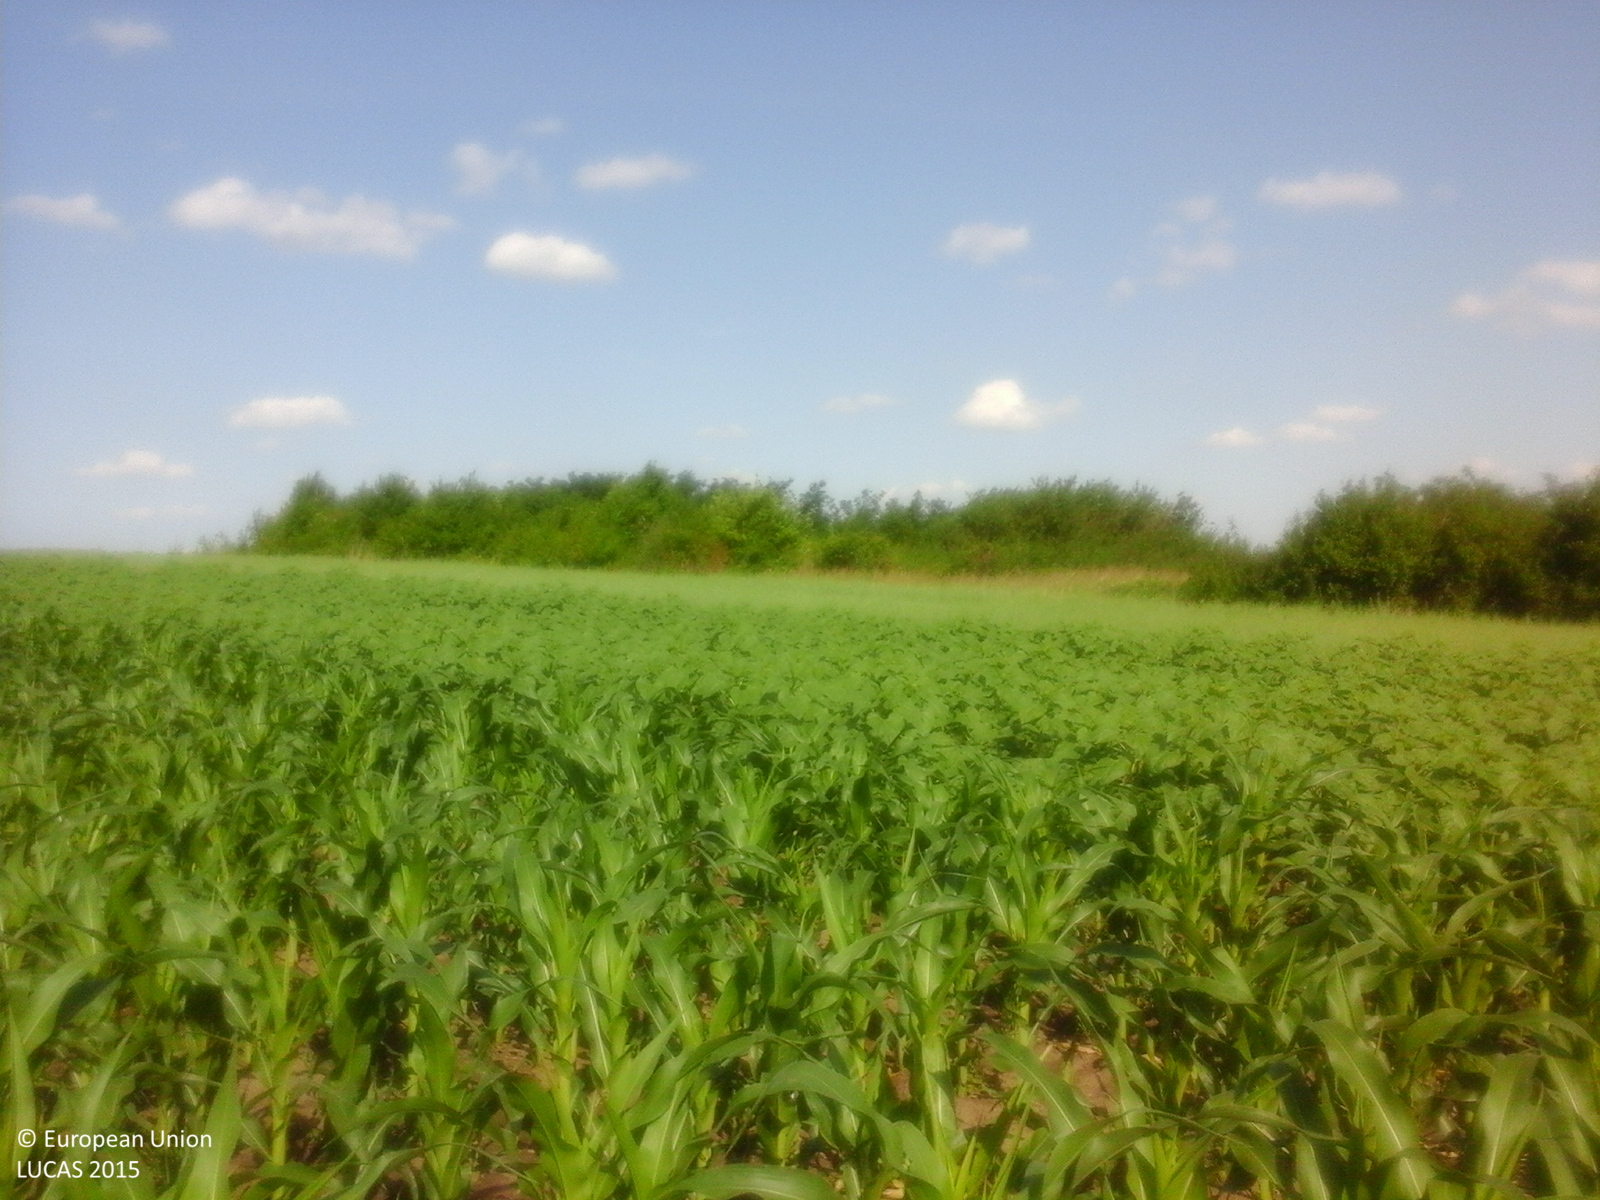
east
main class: Cropland
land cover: Maize
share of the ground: > 75 %
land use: Agriculture (excluding fallow land and kitchen gardens)
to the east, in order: Maize; Sunflower; Oats; Abandoned hedges; Sunflower; Shrubland with sparse tree cover; Maize
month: June
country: RO
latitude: 47.8734
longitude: 26.4687
